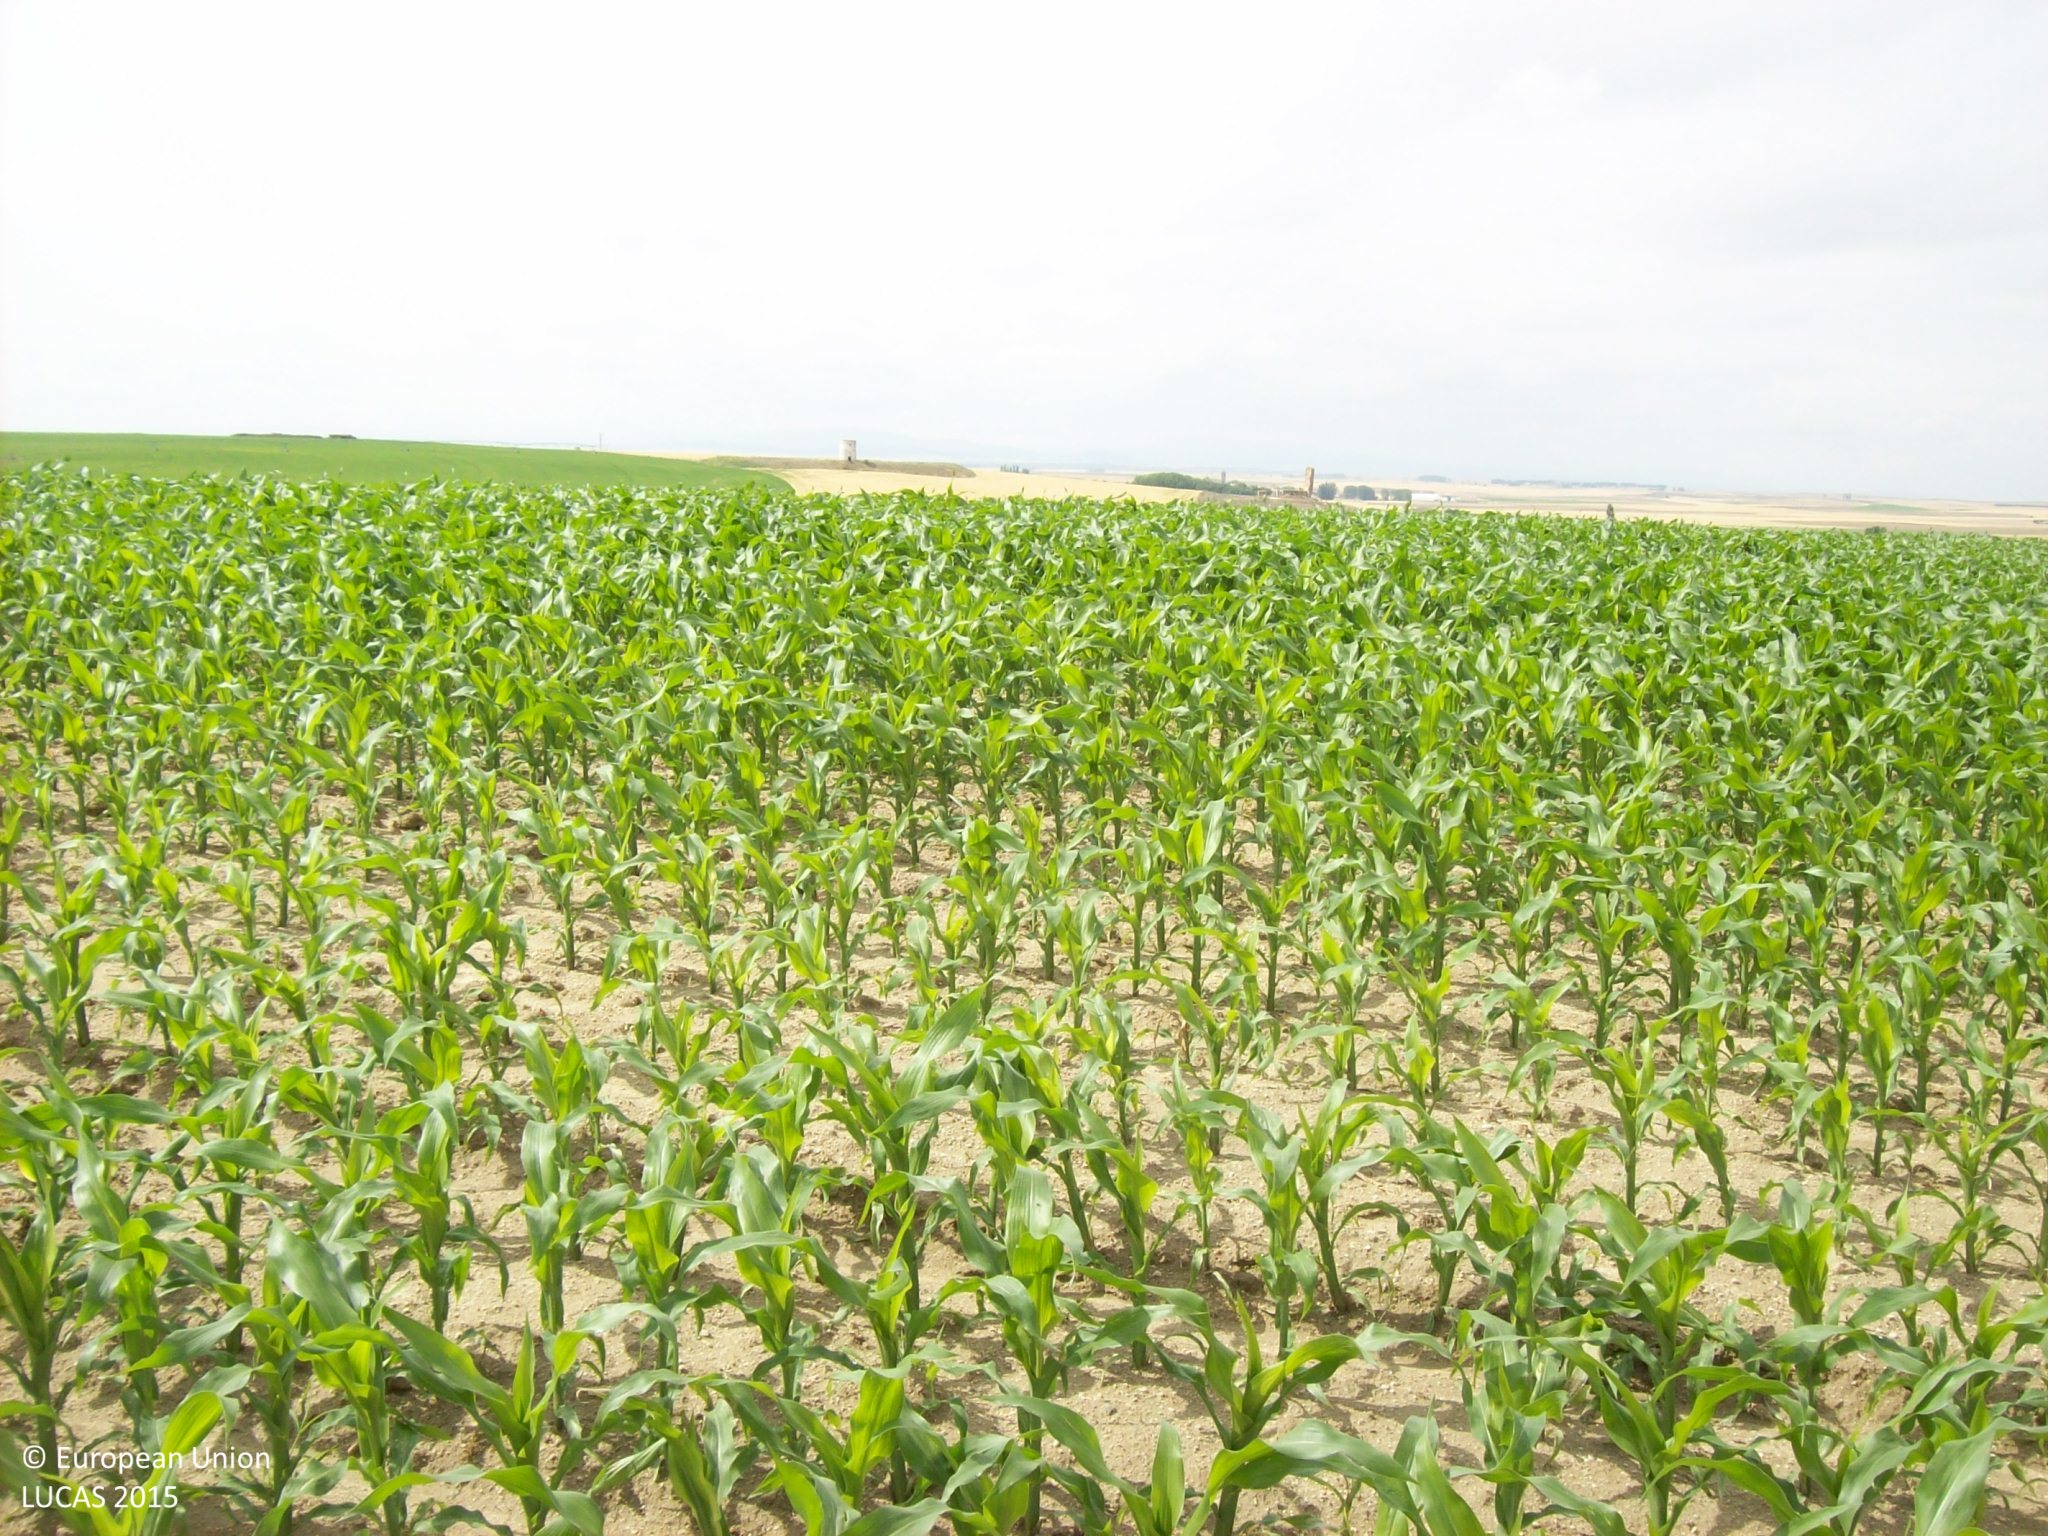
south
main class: Cropland
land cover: Maize
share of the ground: > 75 %
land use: Agriculture (excluding fallow land and kitchen gardens)
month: June
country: ES
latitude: 40.9964
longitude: -5.0085
